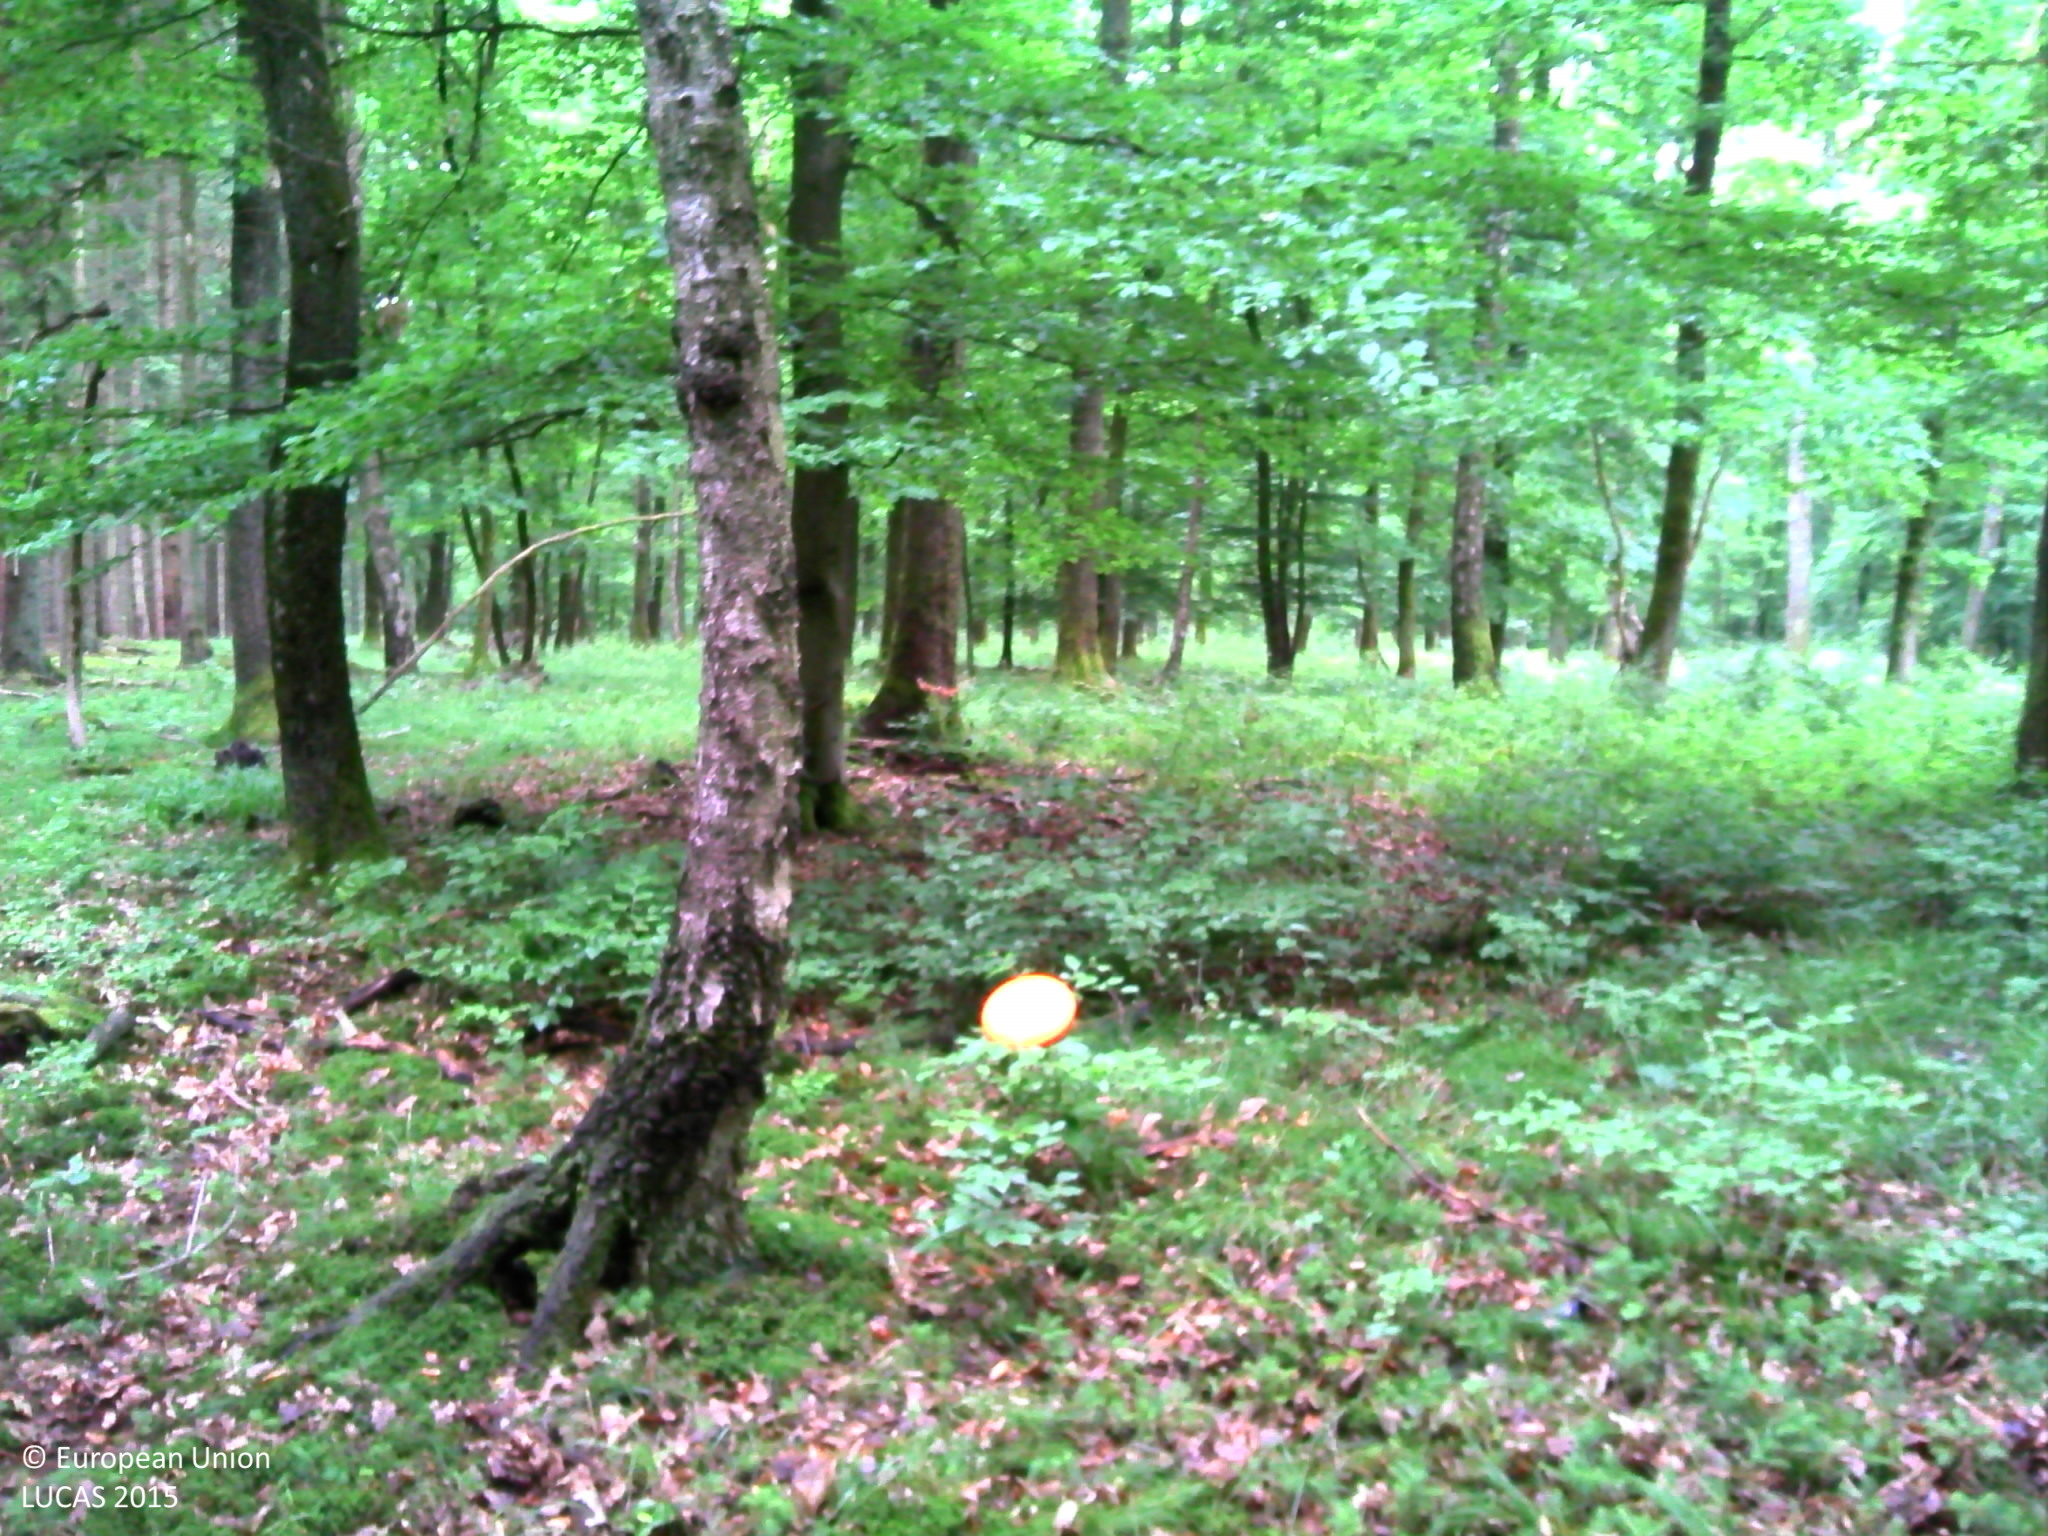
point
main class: Woodland
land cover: Broadleaved woodland
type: acidophilous oak and oak-birch forest
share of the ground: > 75 %
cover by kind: broadleaved forest trees 85 %, coniferous forest trees 5 %, herbaceous plants 5 %, lichens and mosses 5 %
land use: Forestry
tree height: > 5 m
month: June
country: BE
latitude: 50.3335
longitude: 5.6011
